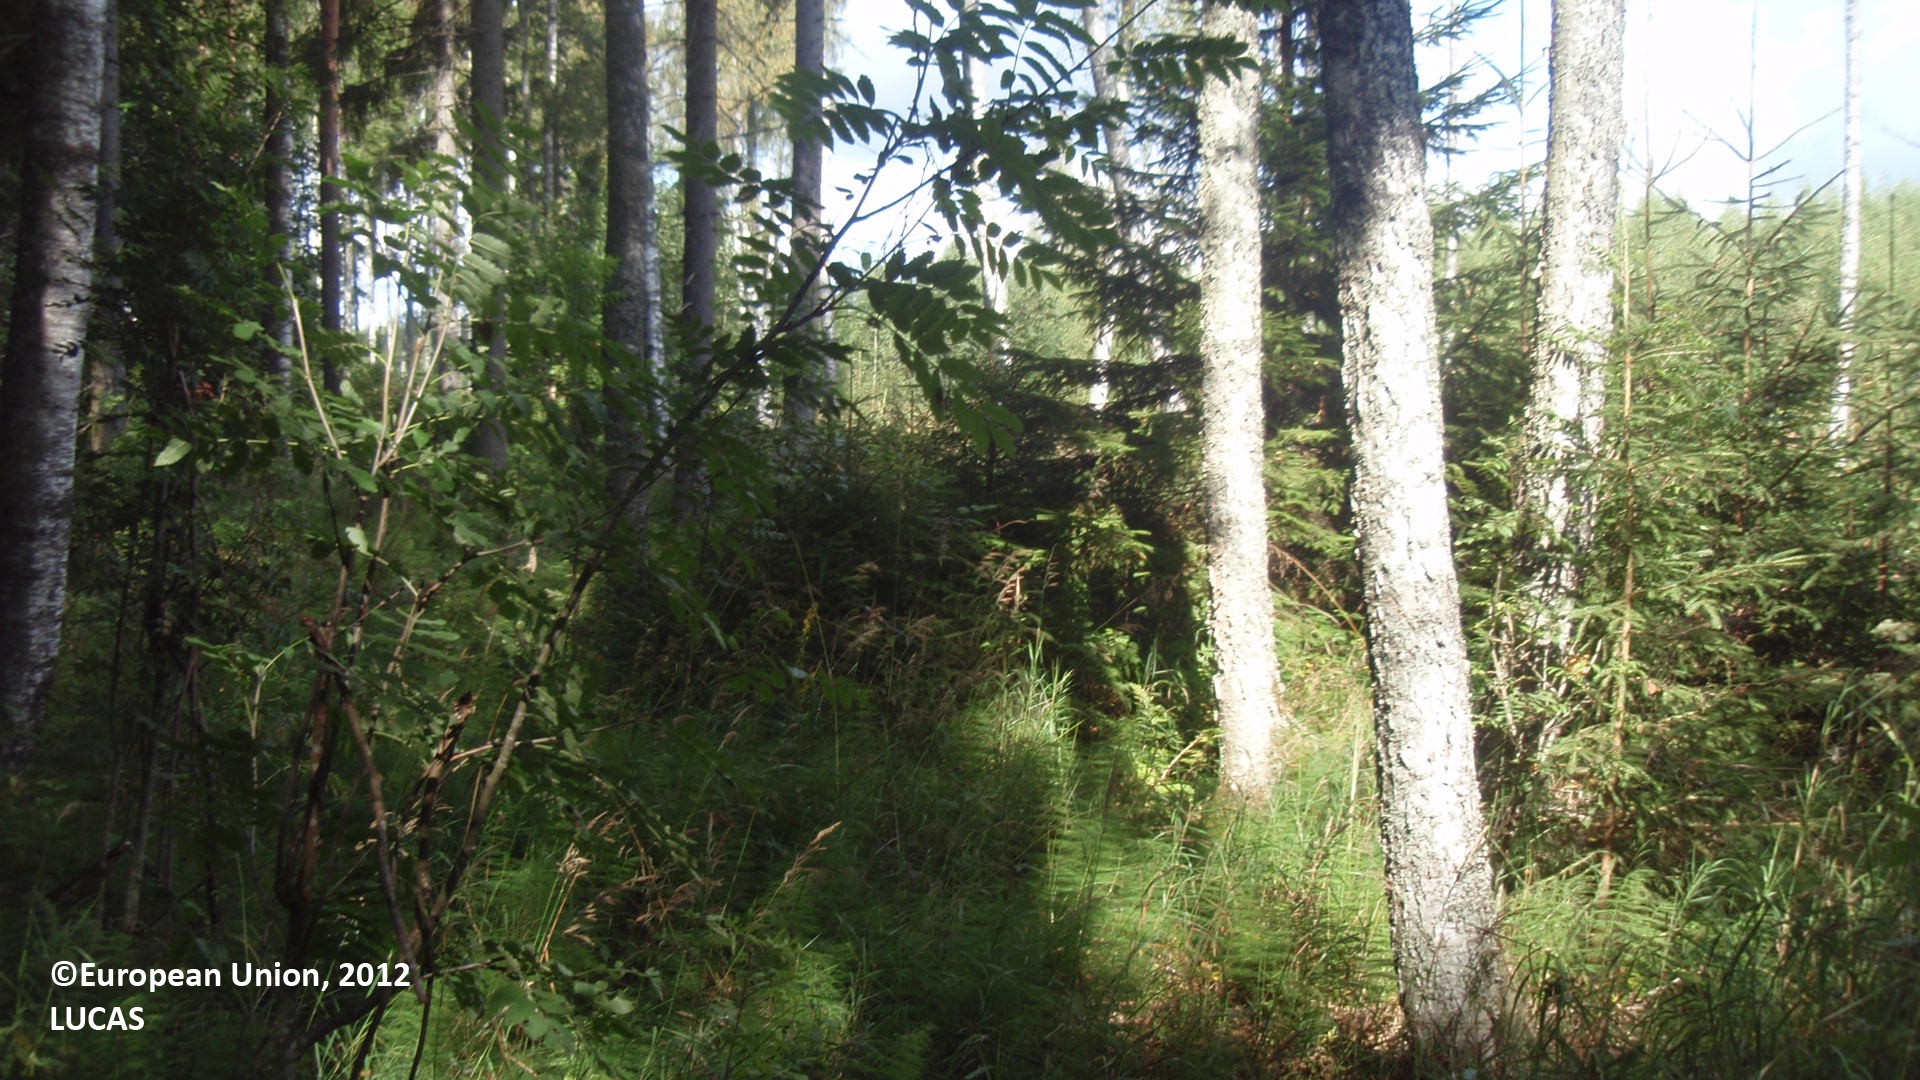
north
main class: Woodland
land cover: Spruce dominated mixed woodland
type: boreal forest
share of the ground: 50 - 75 %
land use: Forestry
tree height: > 5 m
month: August
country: FI
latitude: 60.8020
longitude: 26.6793
